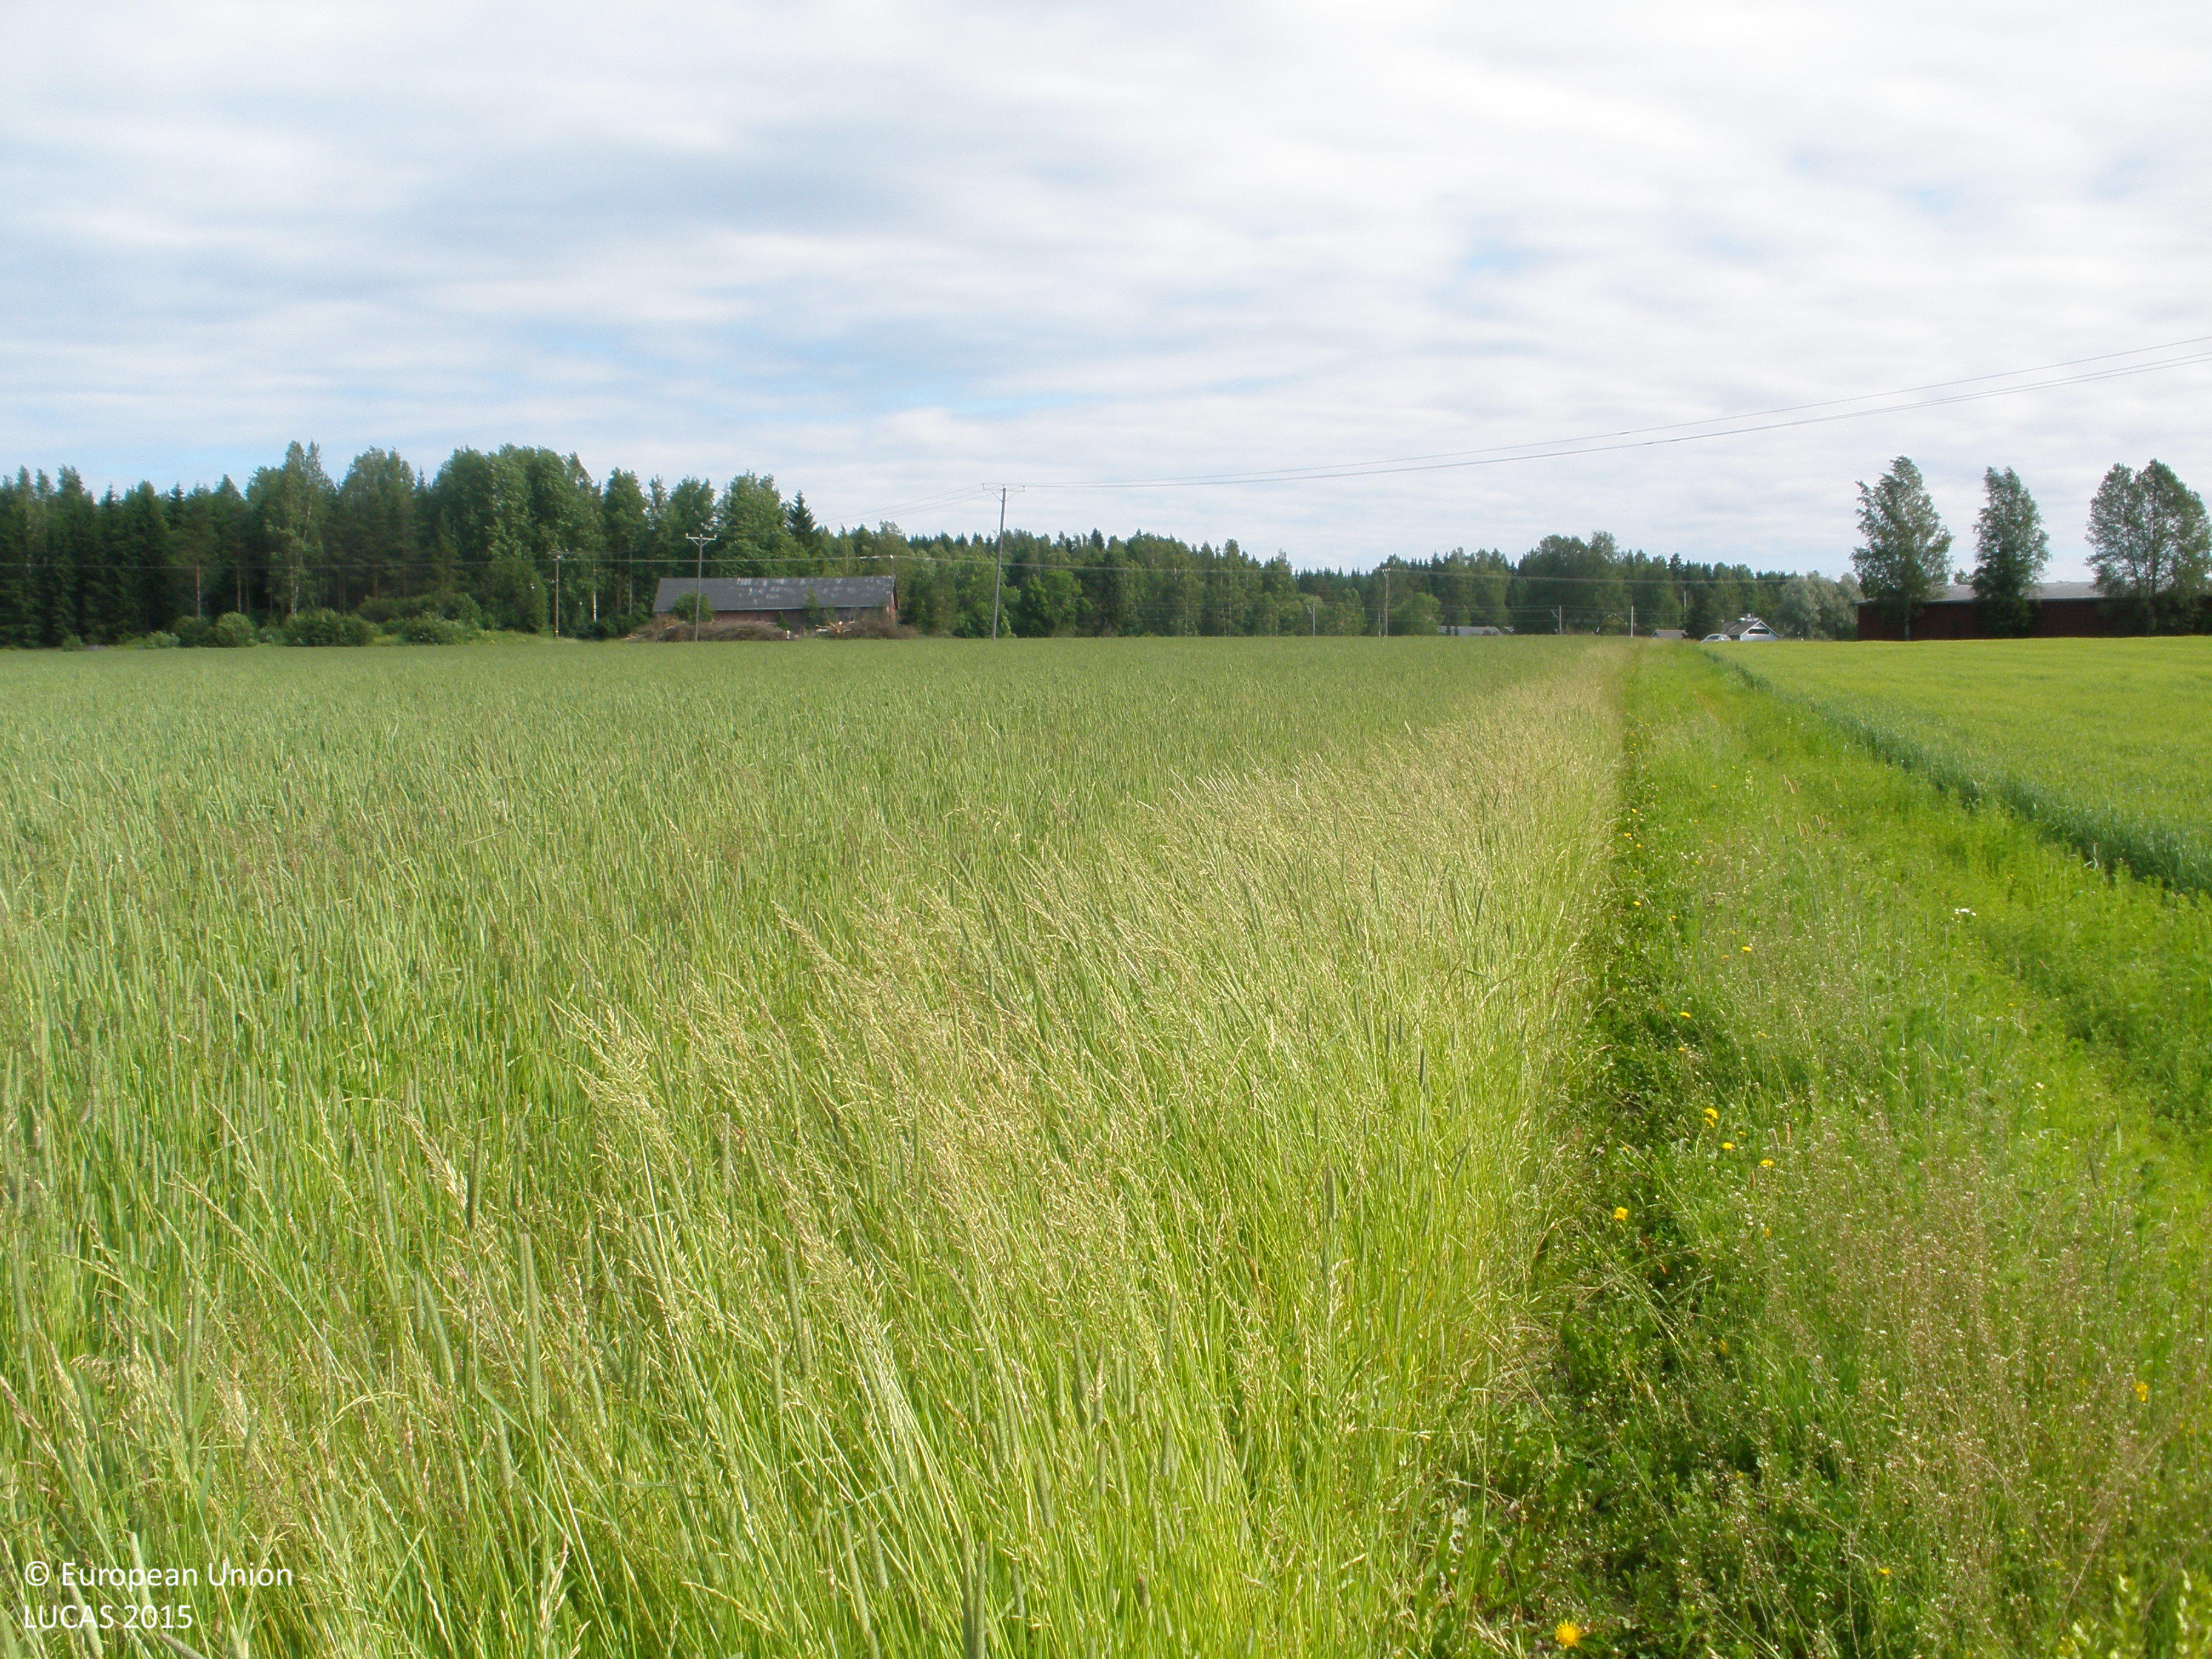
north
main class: Cropland
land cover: Mixed cereals for fodder
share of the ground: > 75 %
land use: Agriculture (excluding fallow land and kitchen gardens)
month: July
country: FI
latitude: 60.8731
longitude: 23.2107
